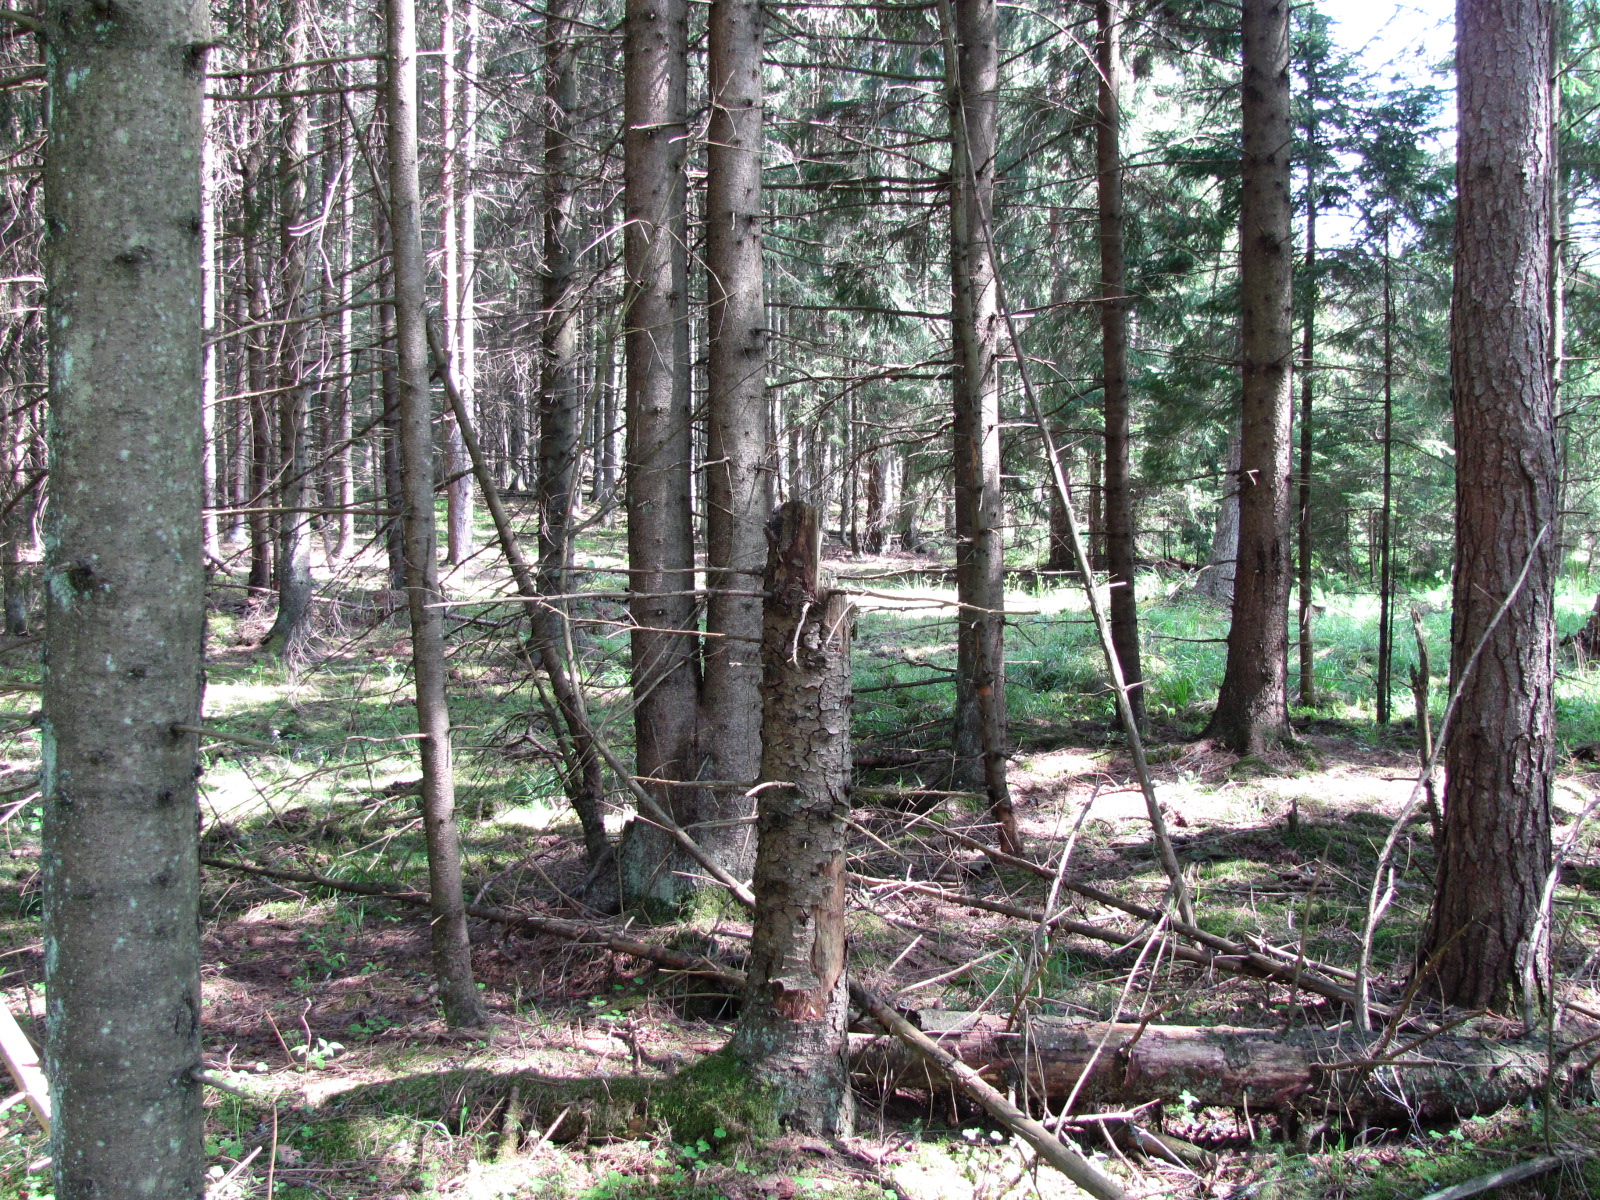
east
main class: Woodland
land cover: Other coniferous woodland
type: hemiboreal forest and nemoral coniferous forest and mixed broadleaved-coniferous forest
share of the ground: > 75 %
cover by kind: coniferous forest trees 100 %
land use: Forestry
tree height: > 5 m
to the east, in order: Other coniferous woodland
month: May
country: LV
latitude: 56.7842
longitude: 24.5153
